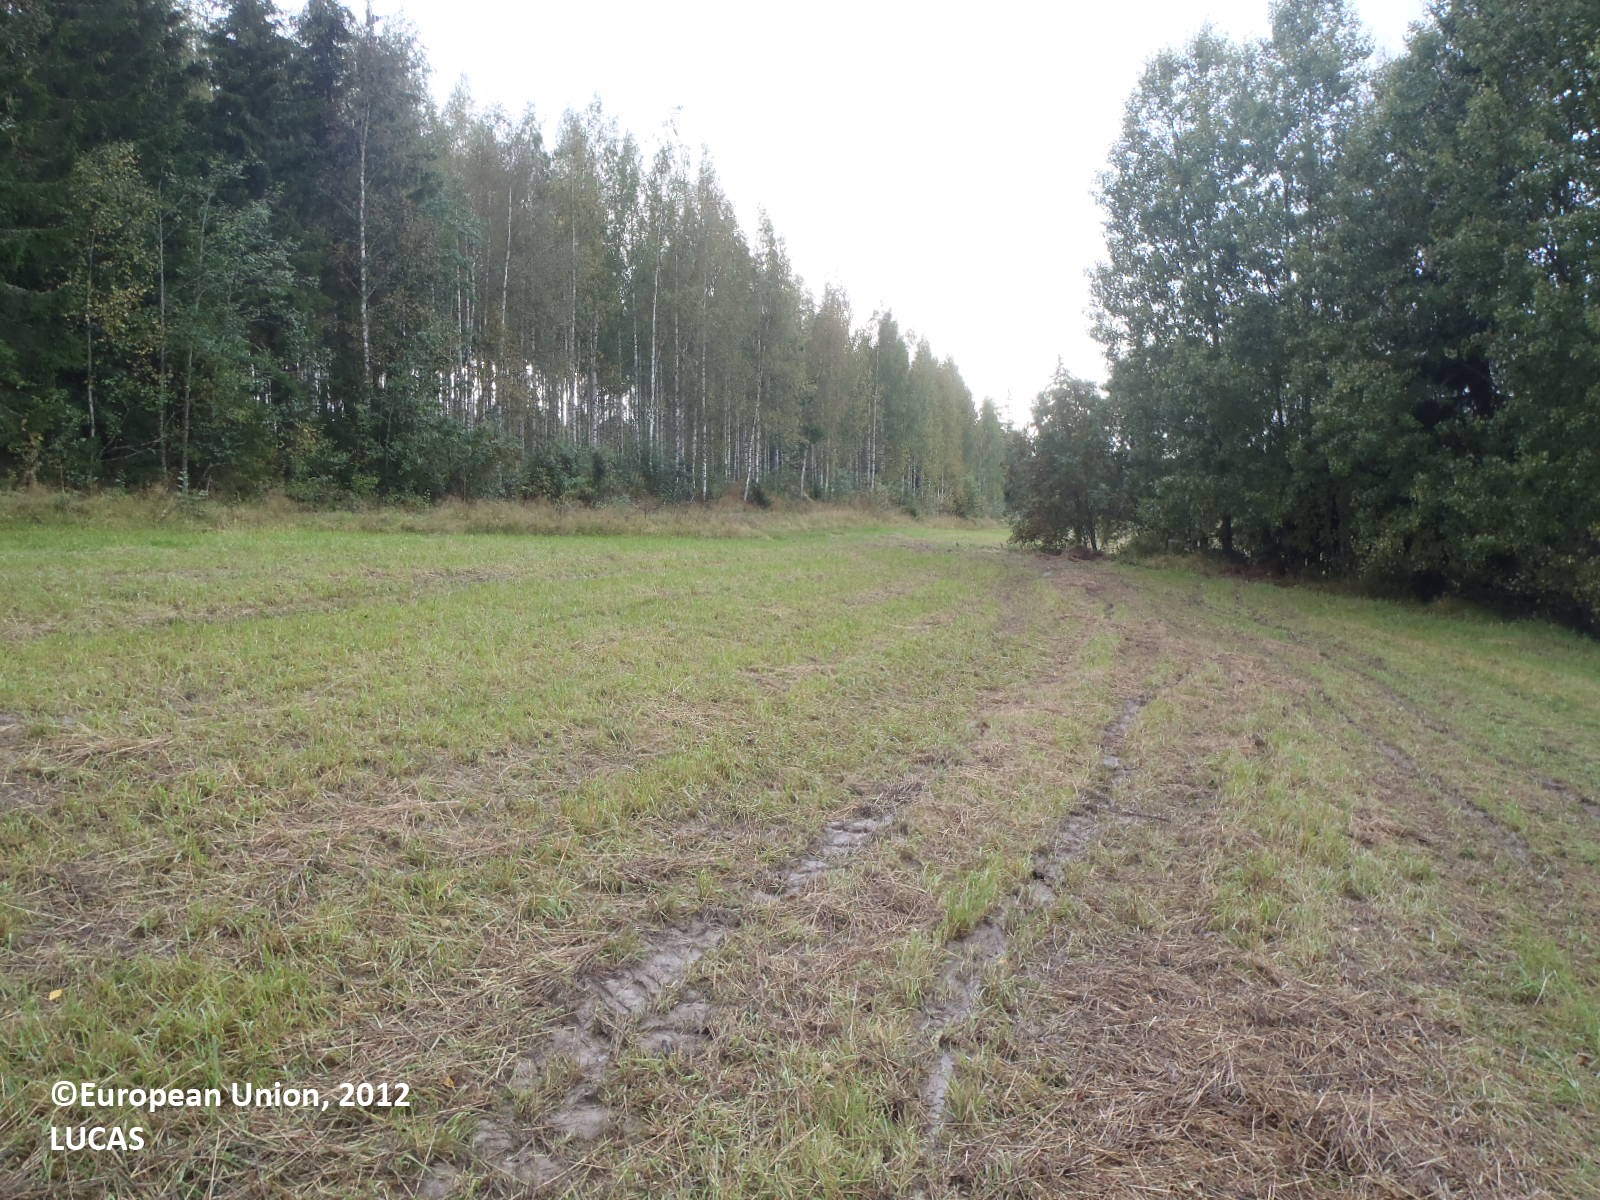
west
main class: Cropland
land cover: Temporary grasslands
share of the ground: > 75 %
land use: Agriculture (excluding fallow land and kitchen gardens)
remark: Harvested field
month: September
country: FI
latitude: 61.5567
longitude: 22.7330
